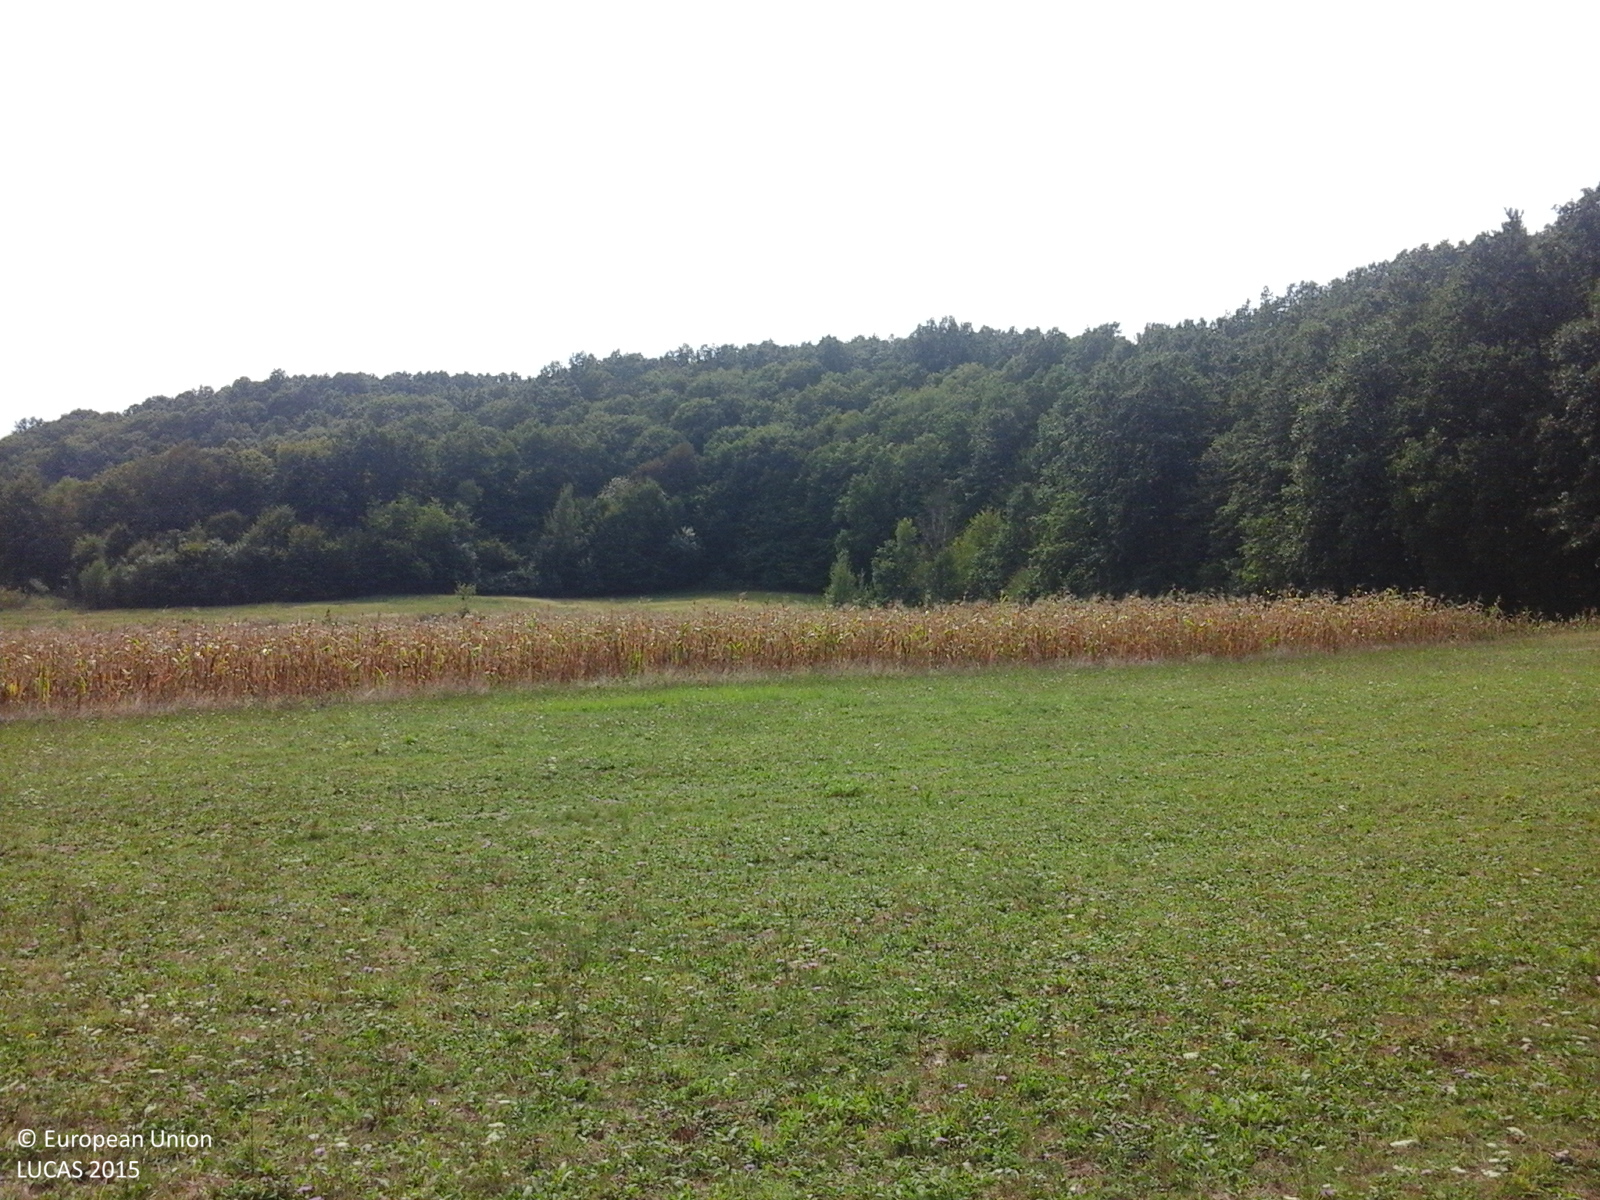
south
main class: Grassland
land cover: Grassland without tree/shrub cover
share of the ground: > 75 %
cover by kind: herbaceous plants 100 %
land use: Agriculture (excluding fallow land and kitchen gardens)
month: September
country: RO
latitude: 45.5203
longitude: 22.0607
